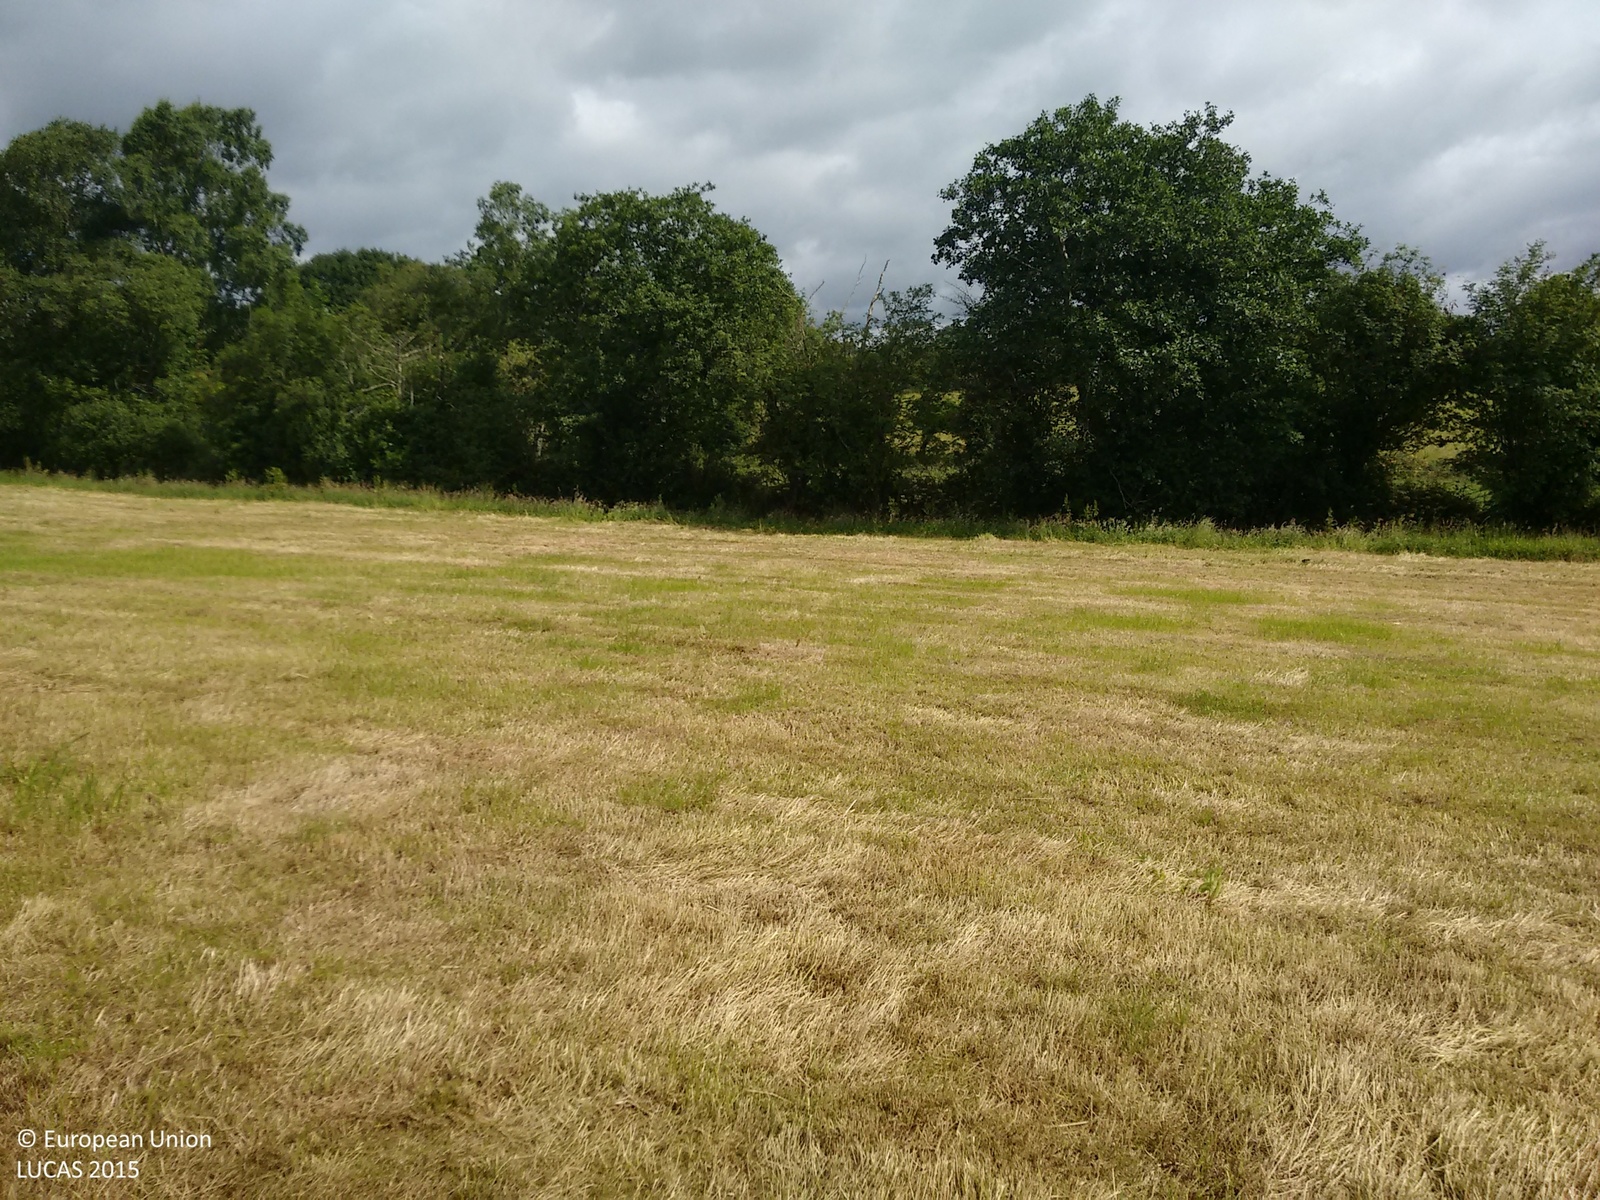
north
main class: Grassland
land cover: Grassland without tree/shrub cover
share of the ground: > 75 %
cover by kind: herbaceous plants 100 %
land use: Agriculture (excluding fallow land and kitchen gardens)
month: July
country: GB
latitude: 54.6001
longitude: -7.3799
